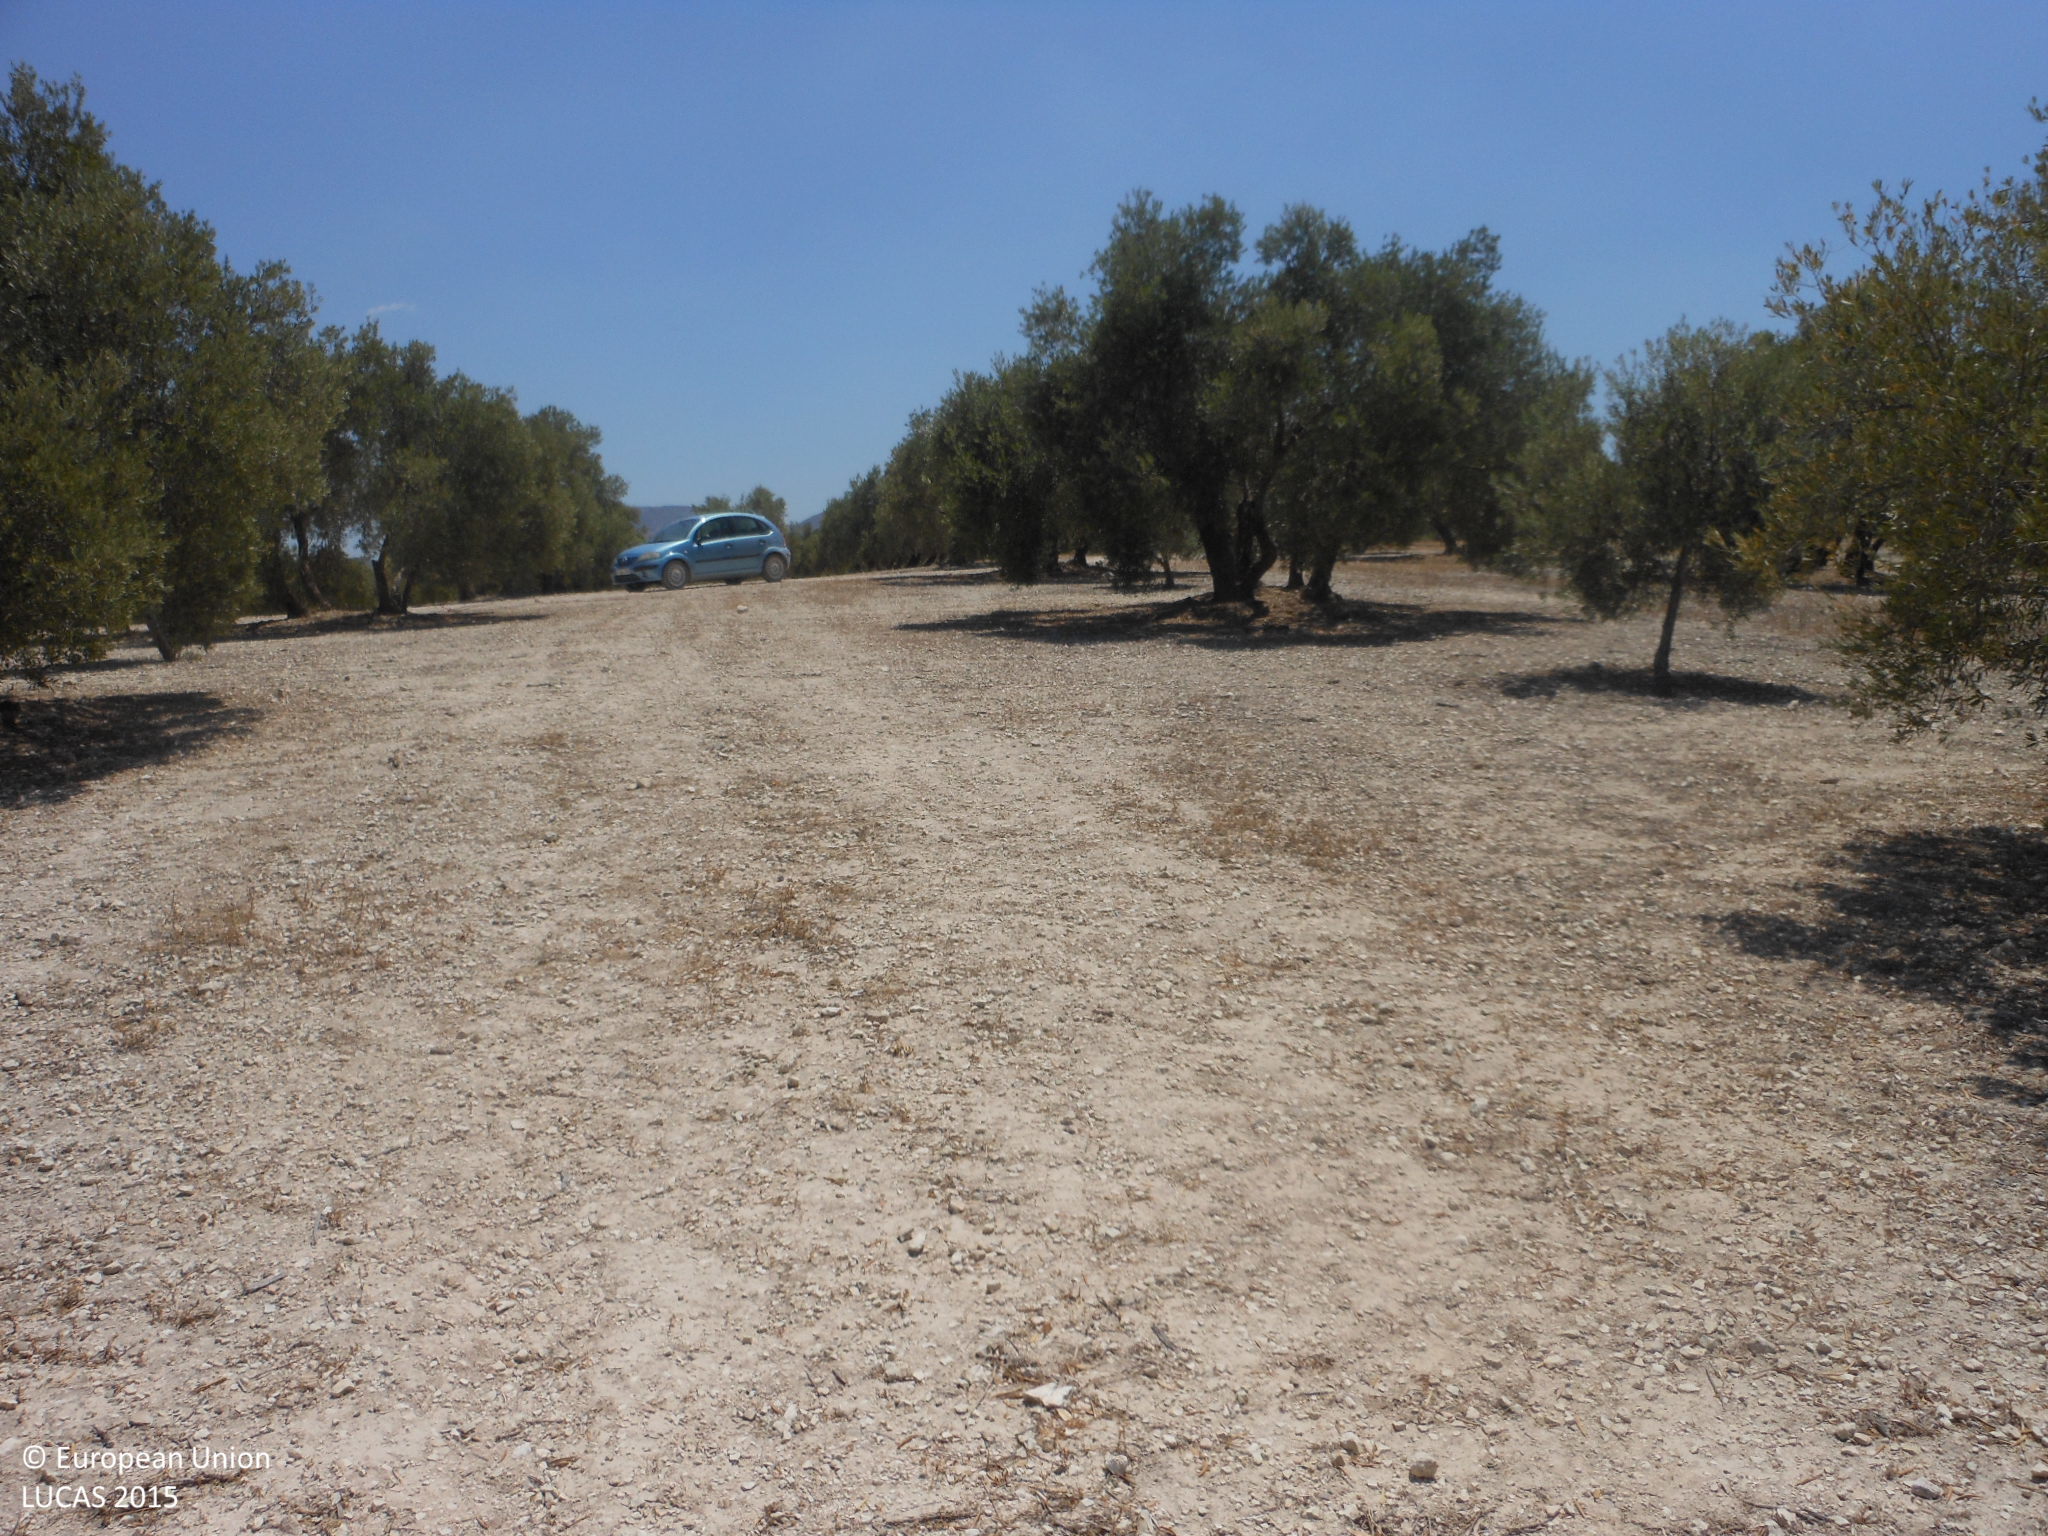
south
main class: Cropland
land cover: Olive groves
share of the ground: 50 - 75 %
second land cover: Other bare soil
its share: > 75 %
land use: Agriculture (excluding fallow land and kitchen gardens)
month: June
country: ES
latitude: 37.3616
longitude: -4.8766
